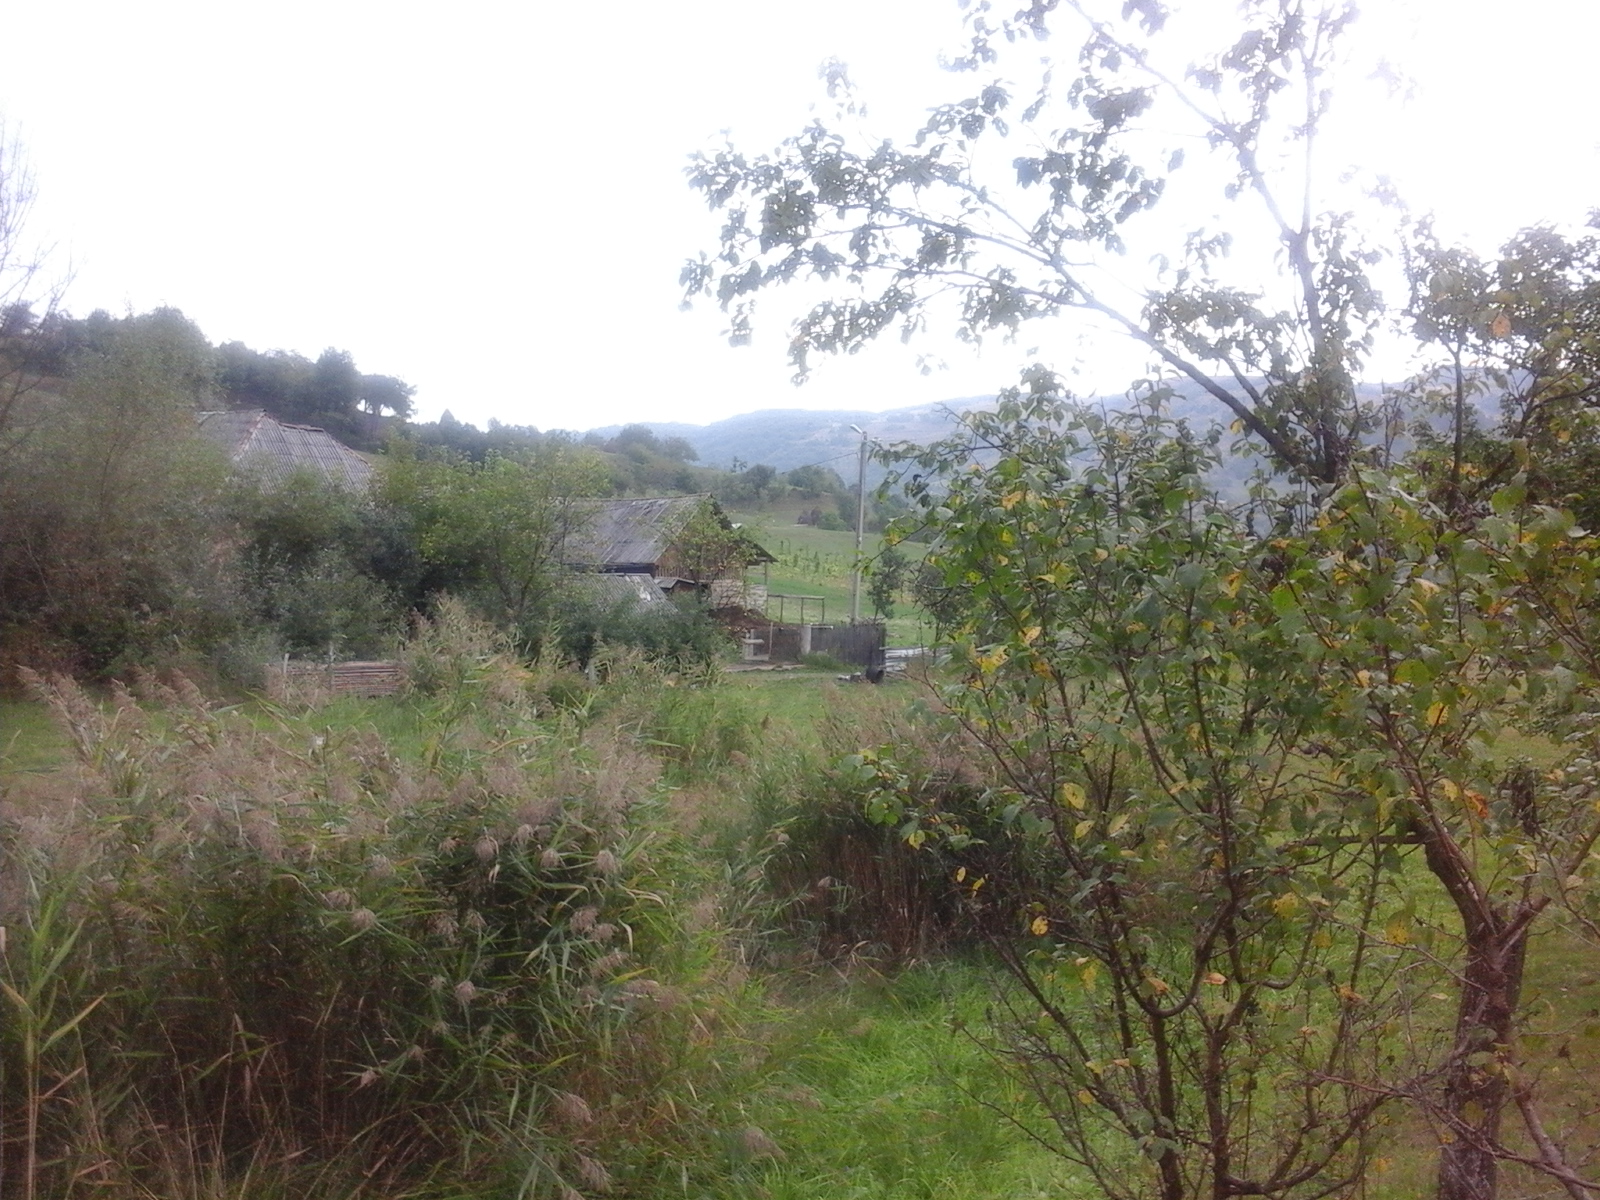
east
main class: Grassland
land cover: Grassland with sparse tree/shrub cover
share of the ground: < 10 %
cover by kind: herbaceous plants 95 %, broadleaved forest trees 5 %
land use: Agriculture (excluding fallow land and kitchen gardens)
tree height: > 5 m
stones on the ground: < 10 %
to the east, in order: Grassland with sparse tree/shrub cover; Grassland without tree/shrub cover; Abandoned hedges; Tracks; Grass margins; Fences; Grassland without tree/shrub cover; Lucerne; Dry pulses; Grassland without tree/shrub cover; Abandoned hedges; Grassland without tree/shrub cover
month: September
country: RO
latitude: 47.7526
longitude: 24.0791
